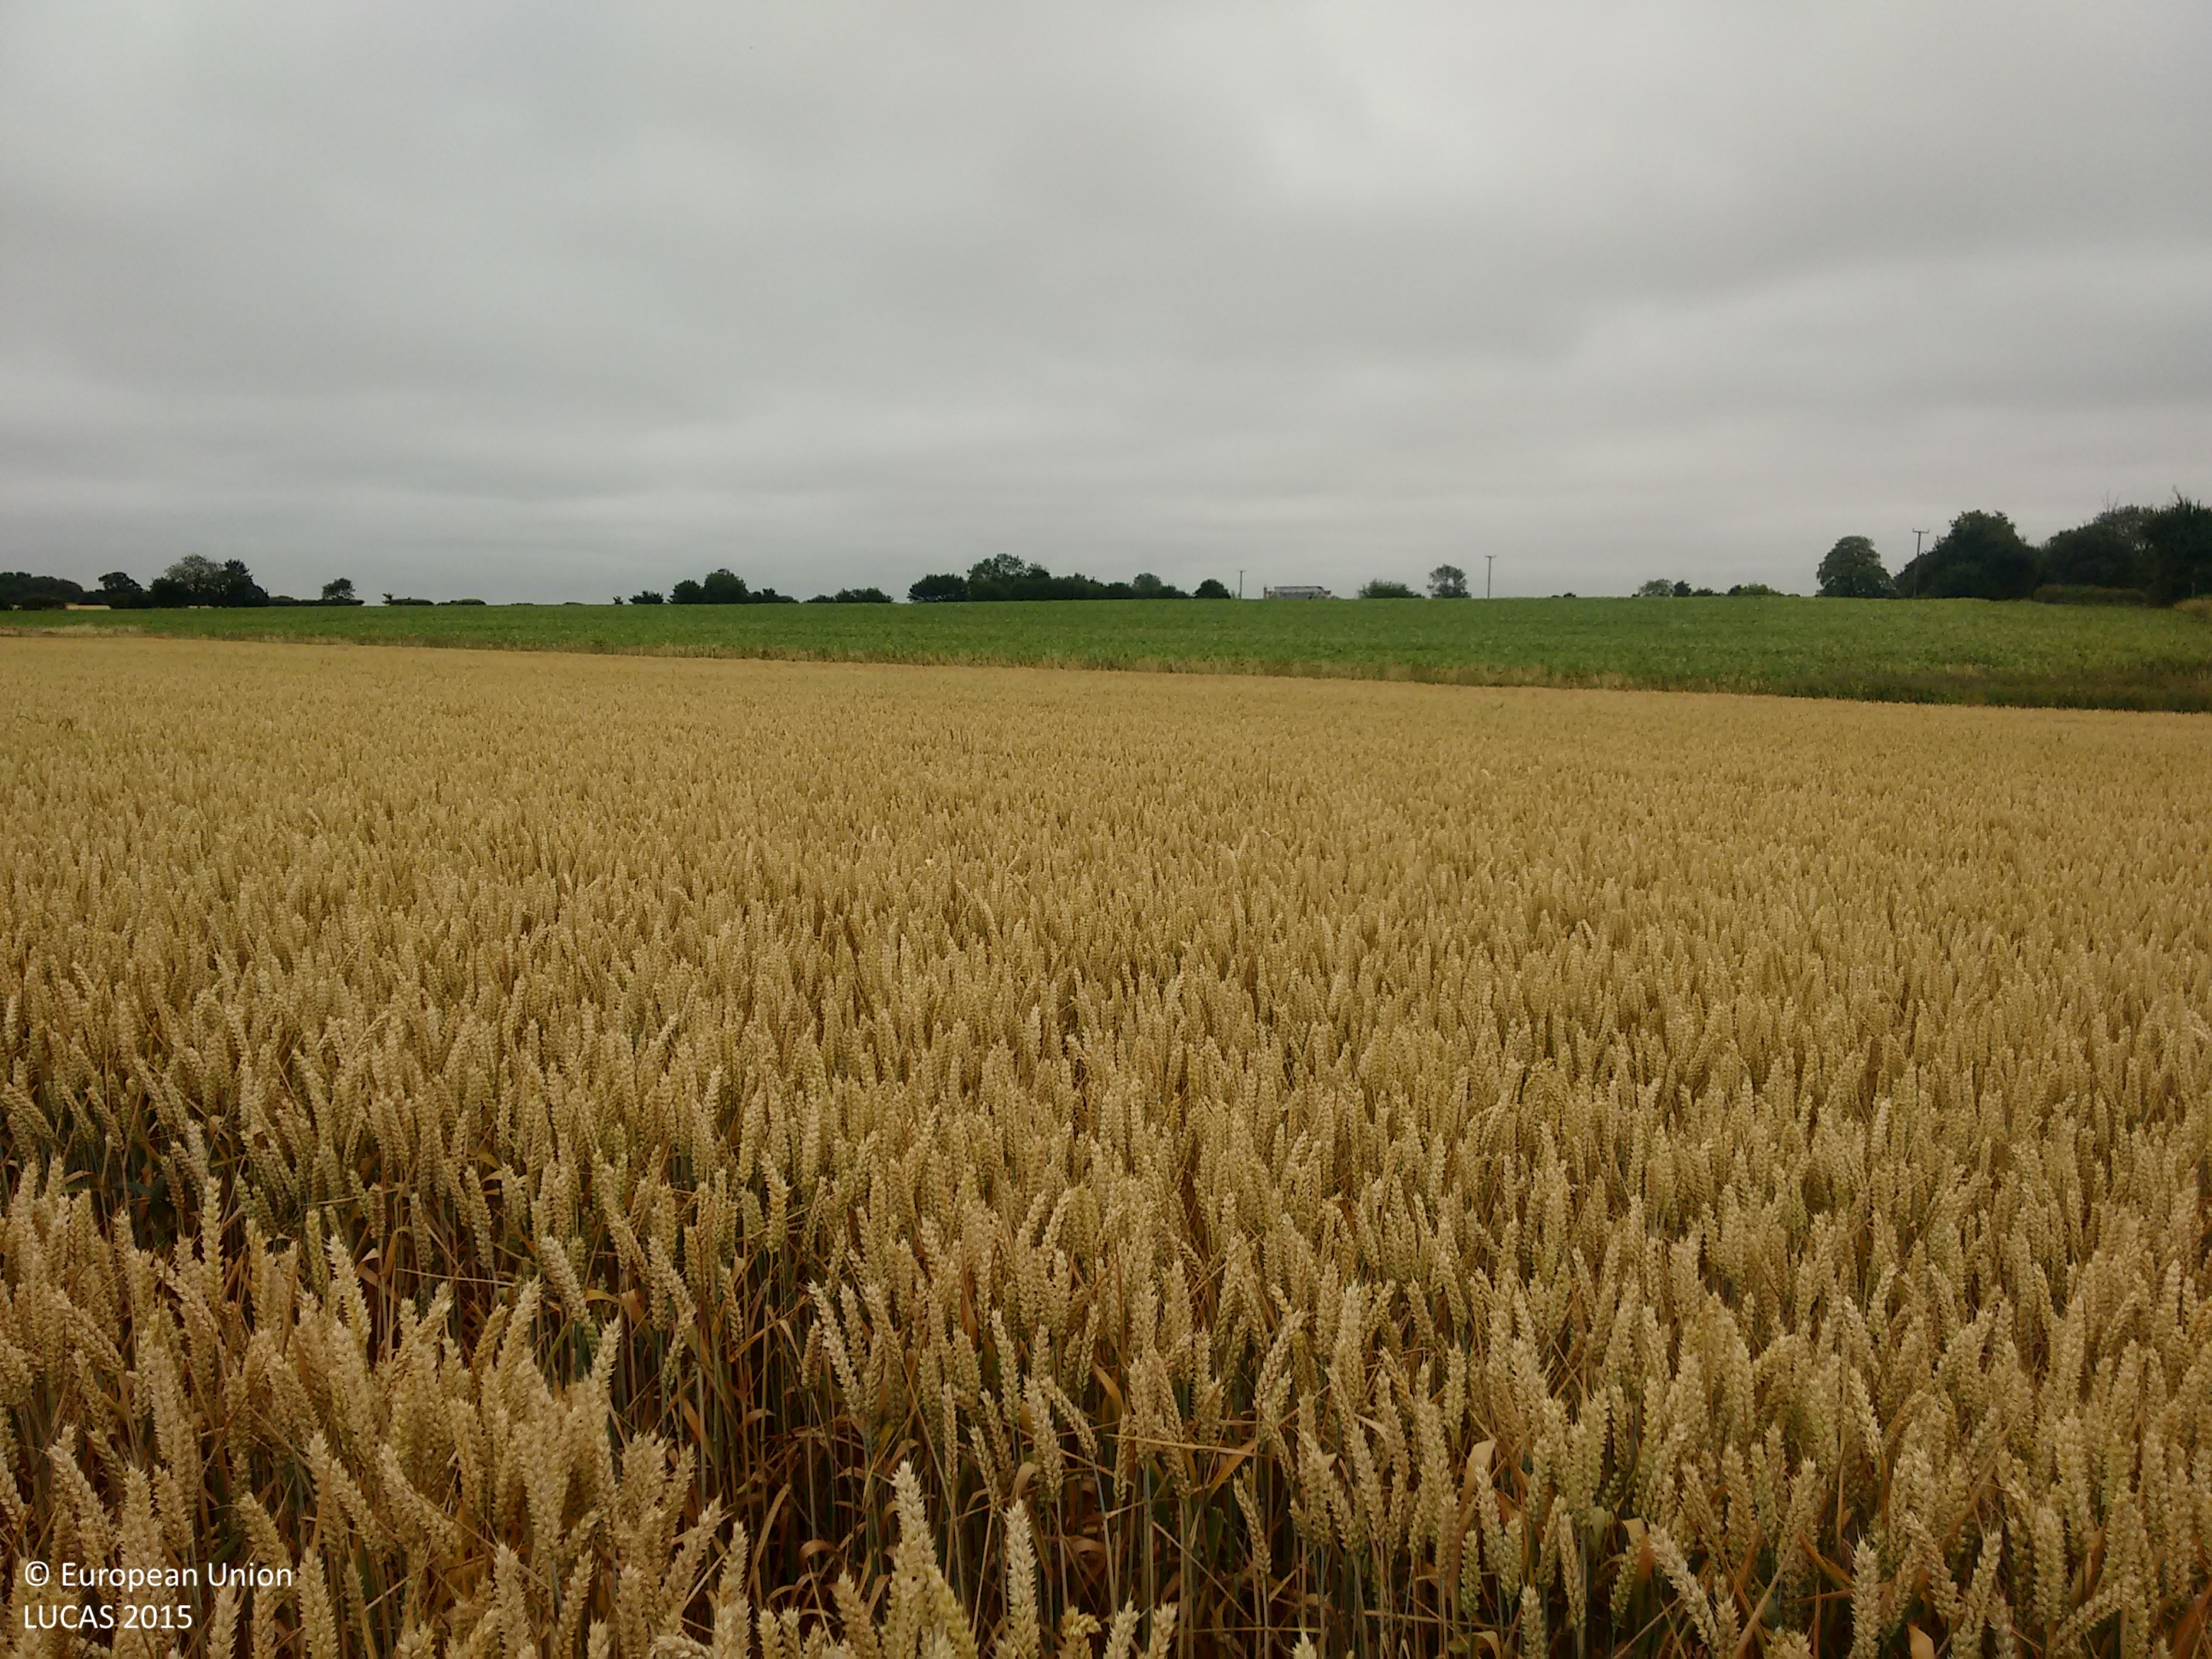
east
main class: Cropland
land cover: Common wheat
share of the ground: > 75 %
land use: Agriculture (excluding fallow land and kitchen gardens)
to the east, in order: Common wheat; Grass margins; Ditches and canals; Grass margins; Tracks; Dry pulses; Grass margins; Ditches and canals; Grass margins; Common wheat
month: July
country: GB
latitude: 51.8183
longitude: 0.3233
